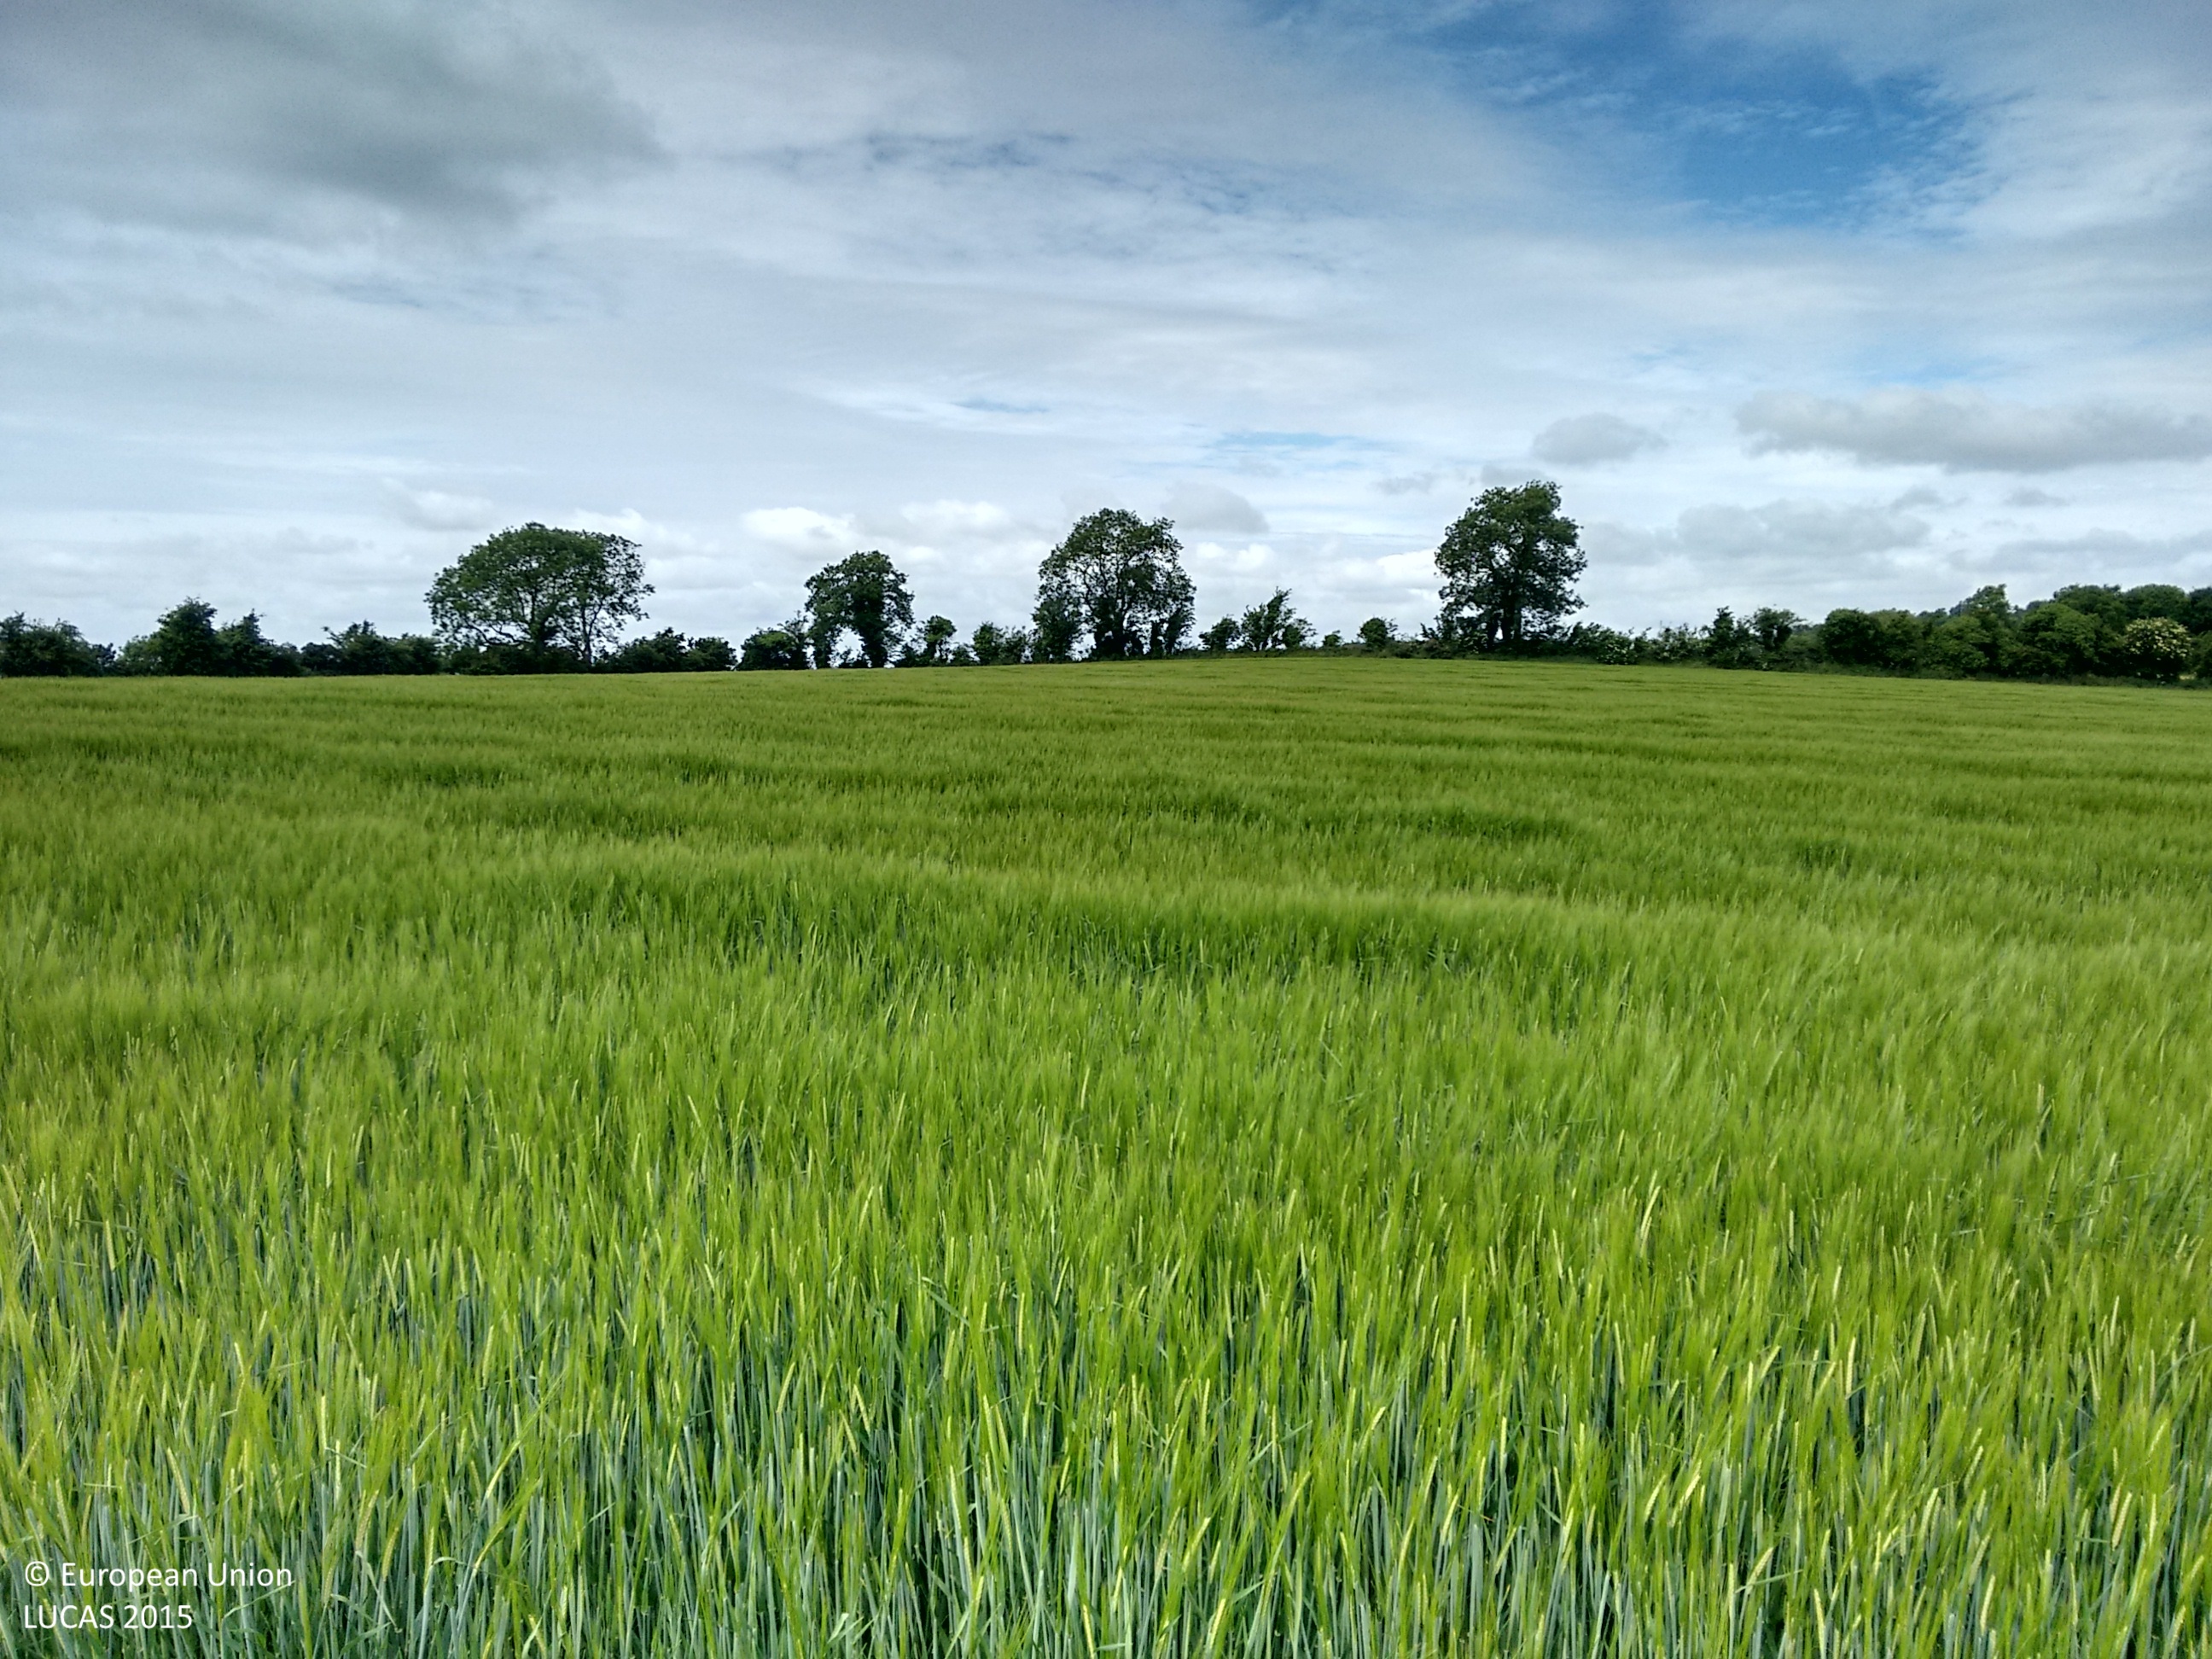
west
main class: Cropland
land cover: Barley
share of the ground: > 75 %
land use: Agriculture (excluding fallow land and kitchen gardens)
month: June
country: IE
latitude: 53.7285
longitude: -6.6364
